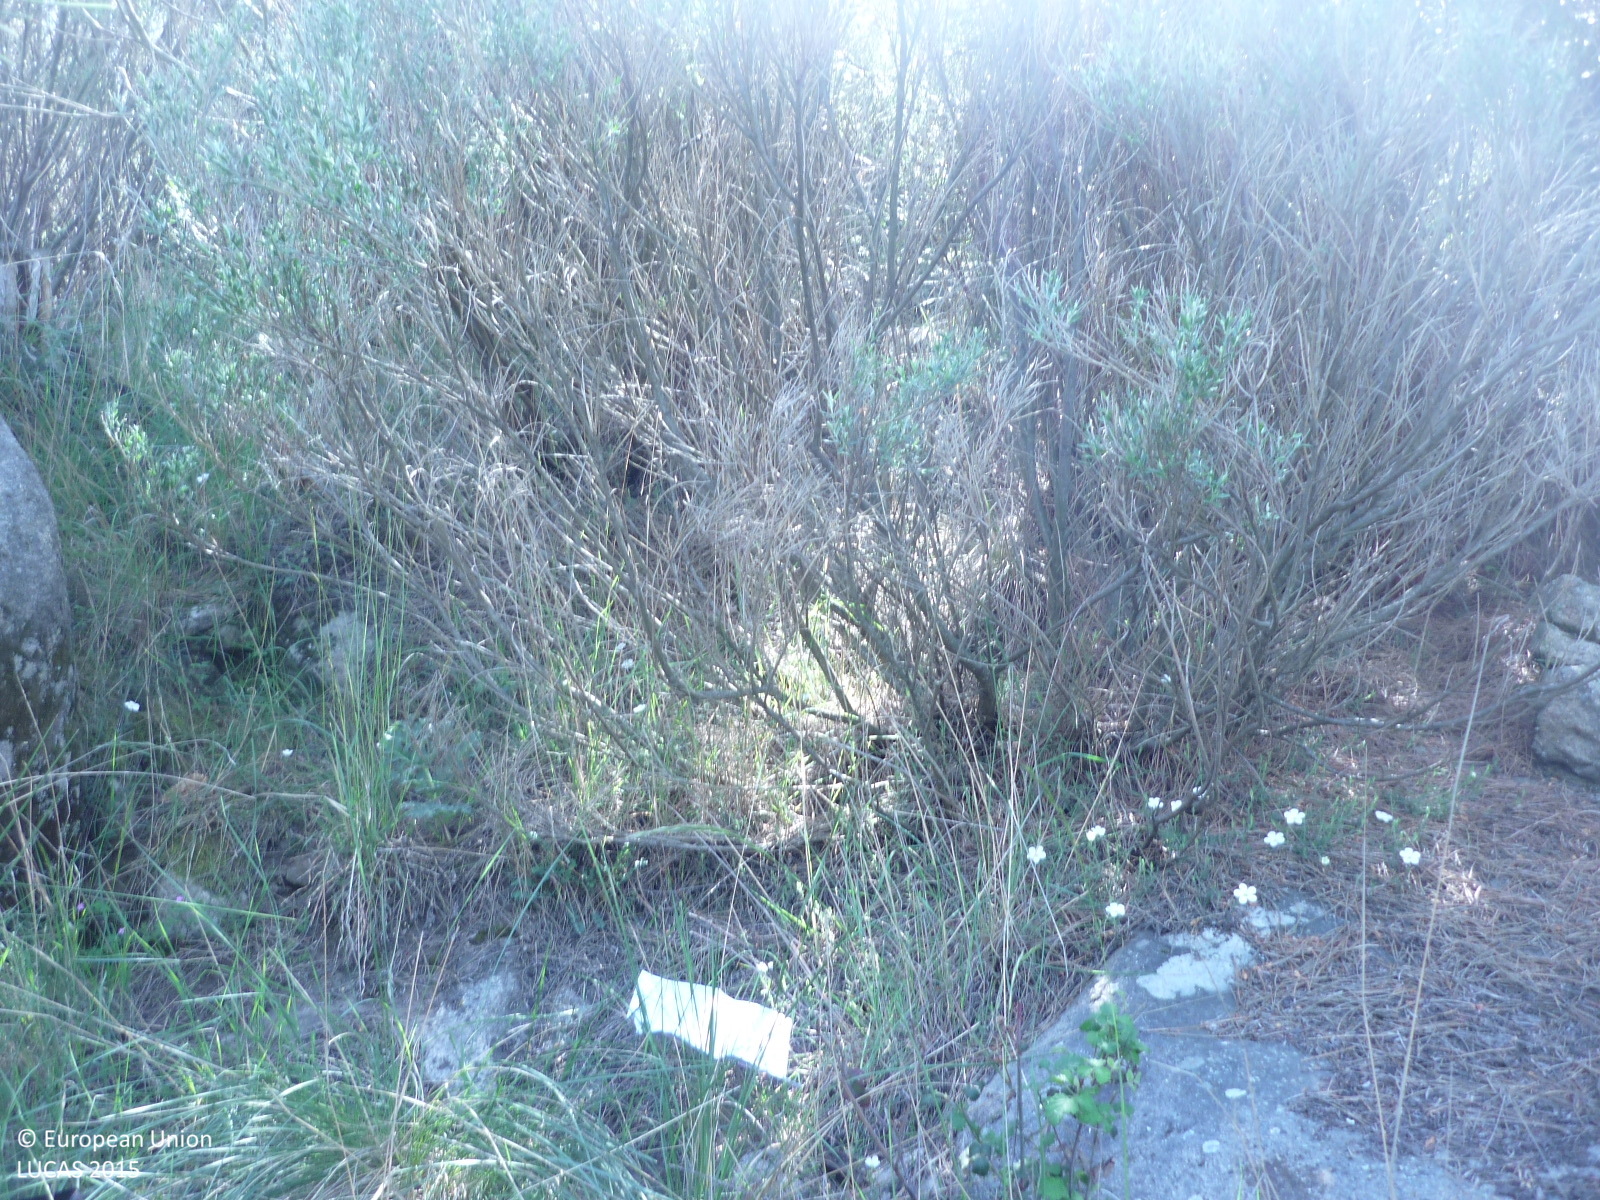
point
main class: Woodland
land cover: Pine dominated coniferous woodland
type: coniferous forest of the mediterranean region
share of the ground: 50 - 75 %
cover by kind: coniferous forest trees 70 %, shrubs 20 %, herbaceous plants 10 %
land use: Semi-natural and natural areas not in use
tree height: < 5 m
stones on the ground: 10 - 25 %
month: May
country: ES
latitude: 40.8892
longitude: -3.6081
